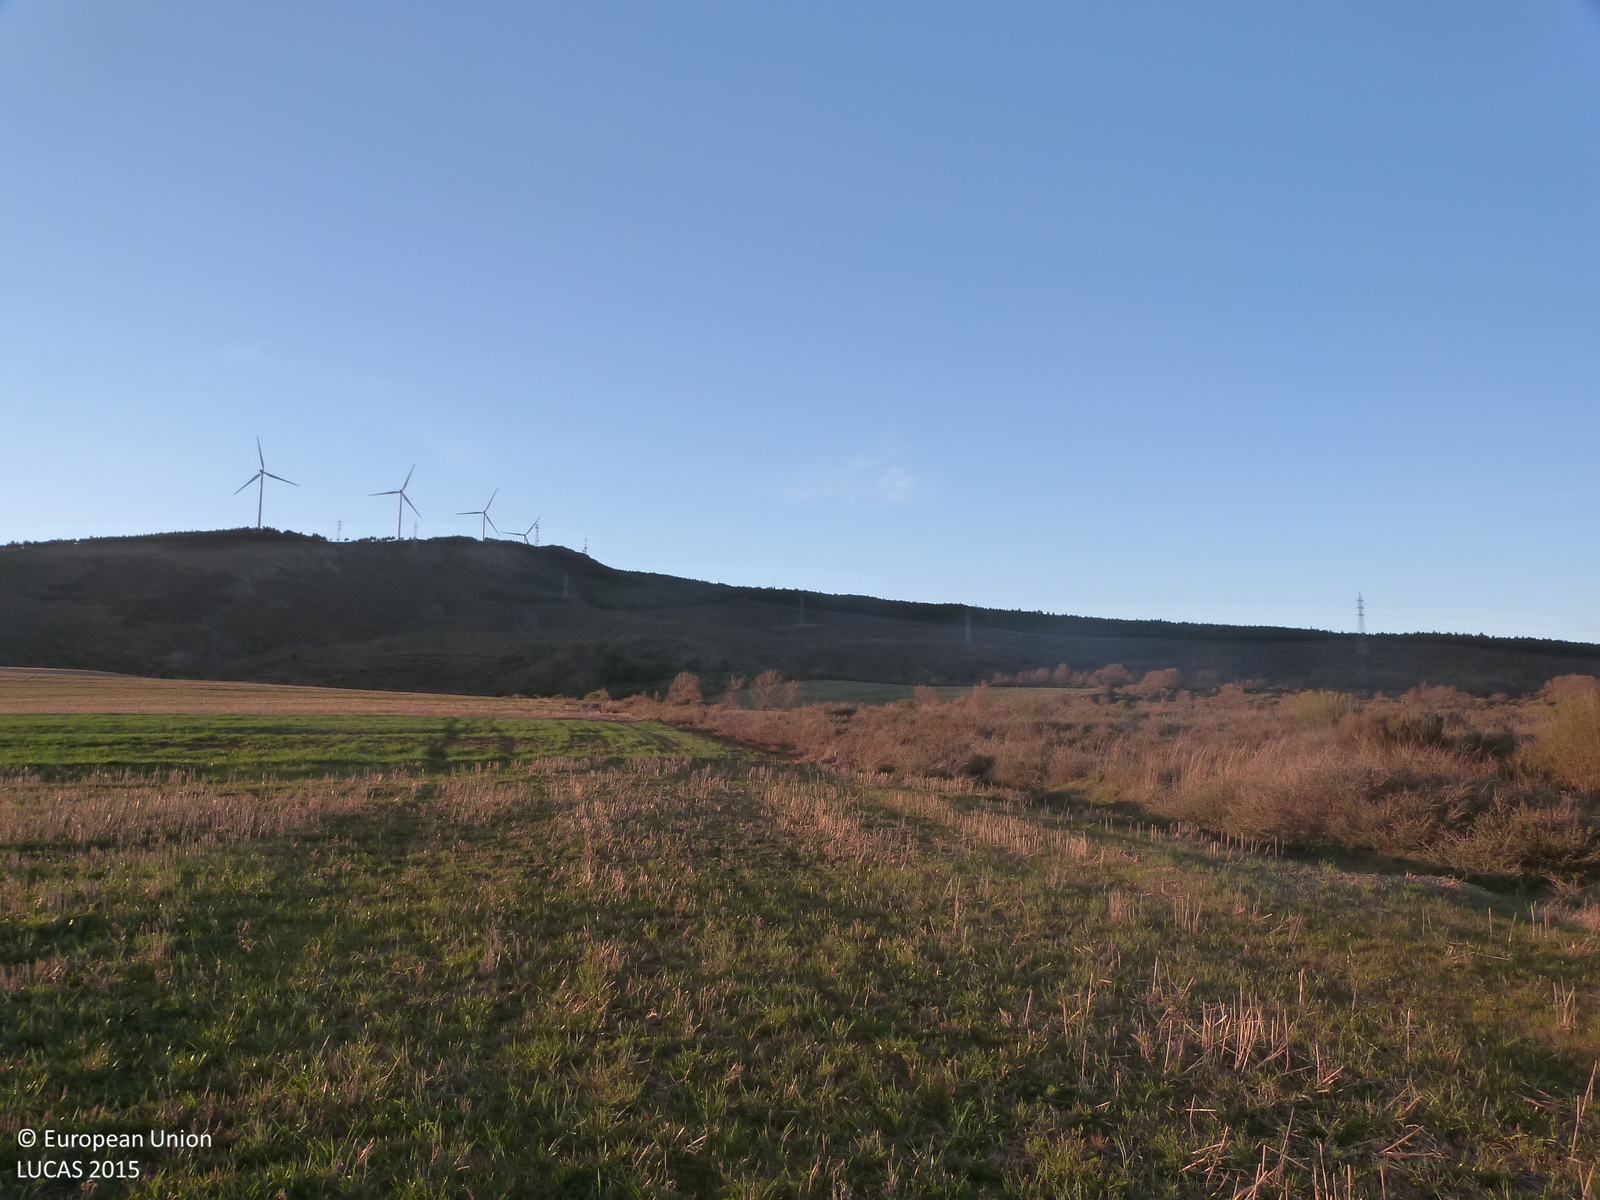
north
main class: Grassland
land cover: Spontaneously vegetated surfaces
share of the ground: > 75 %
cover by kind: herbaceous plants 95 %, shrubs 5 %
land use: Fallow land
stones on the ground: 10 - 25 %
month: April
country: ES
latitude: 42.6427
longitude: -6.0986
